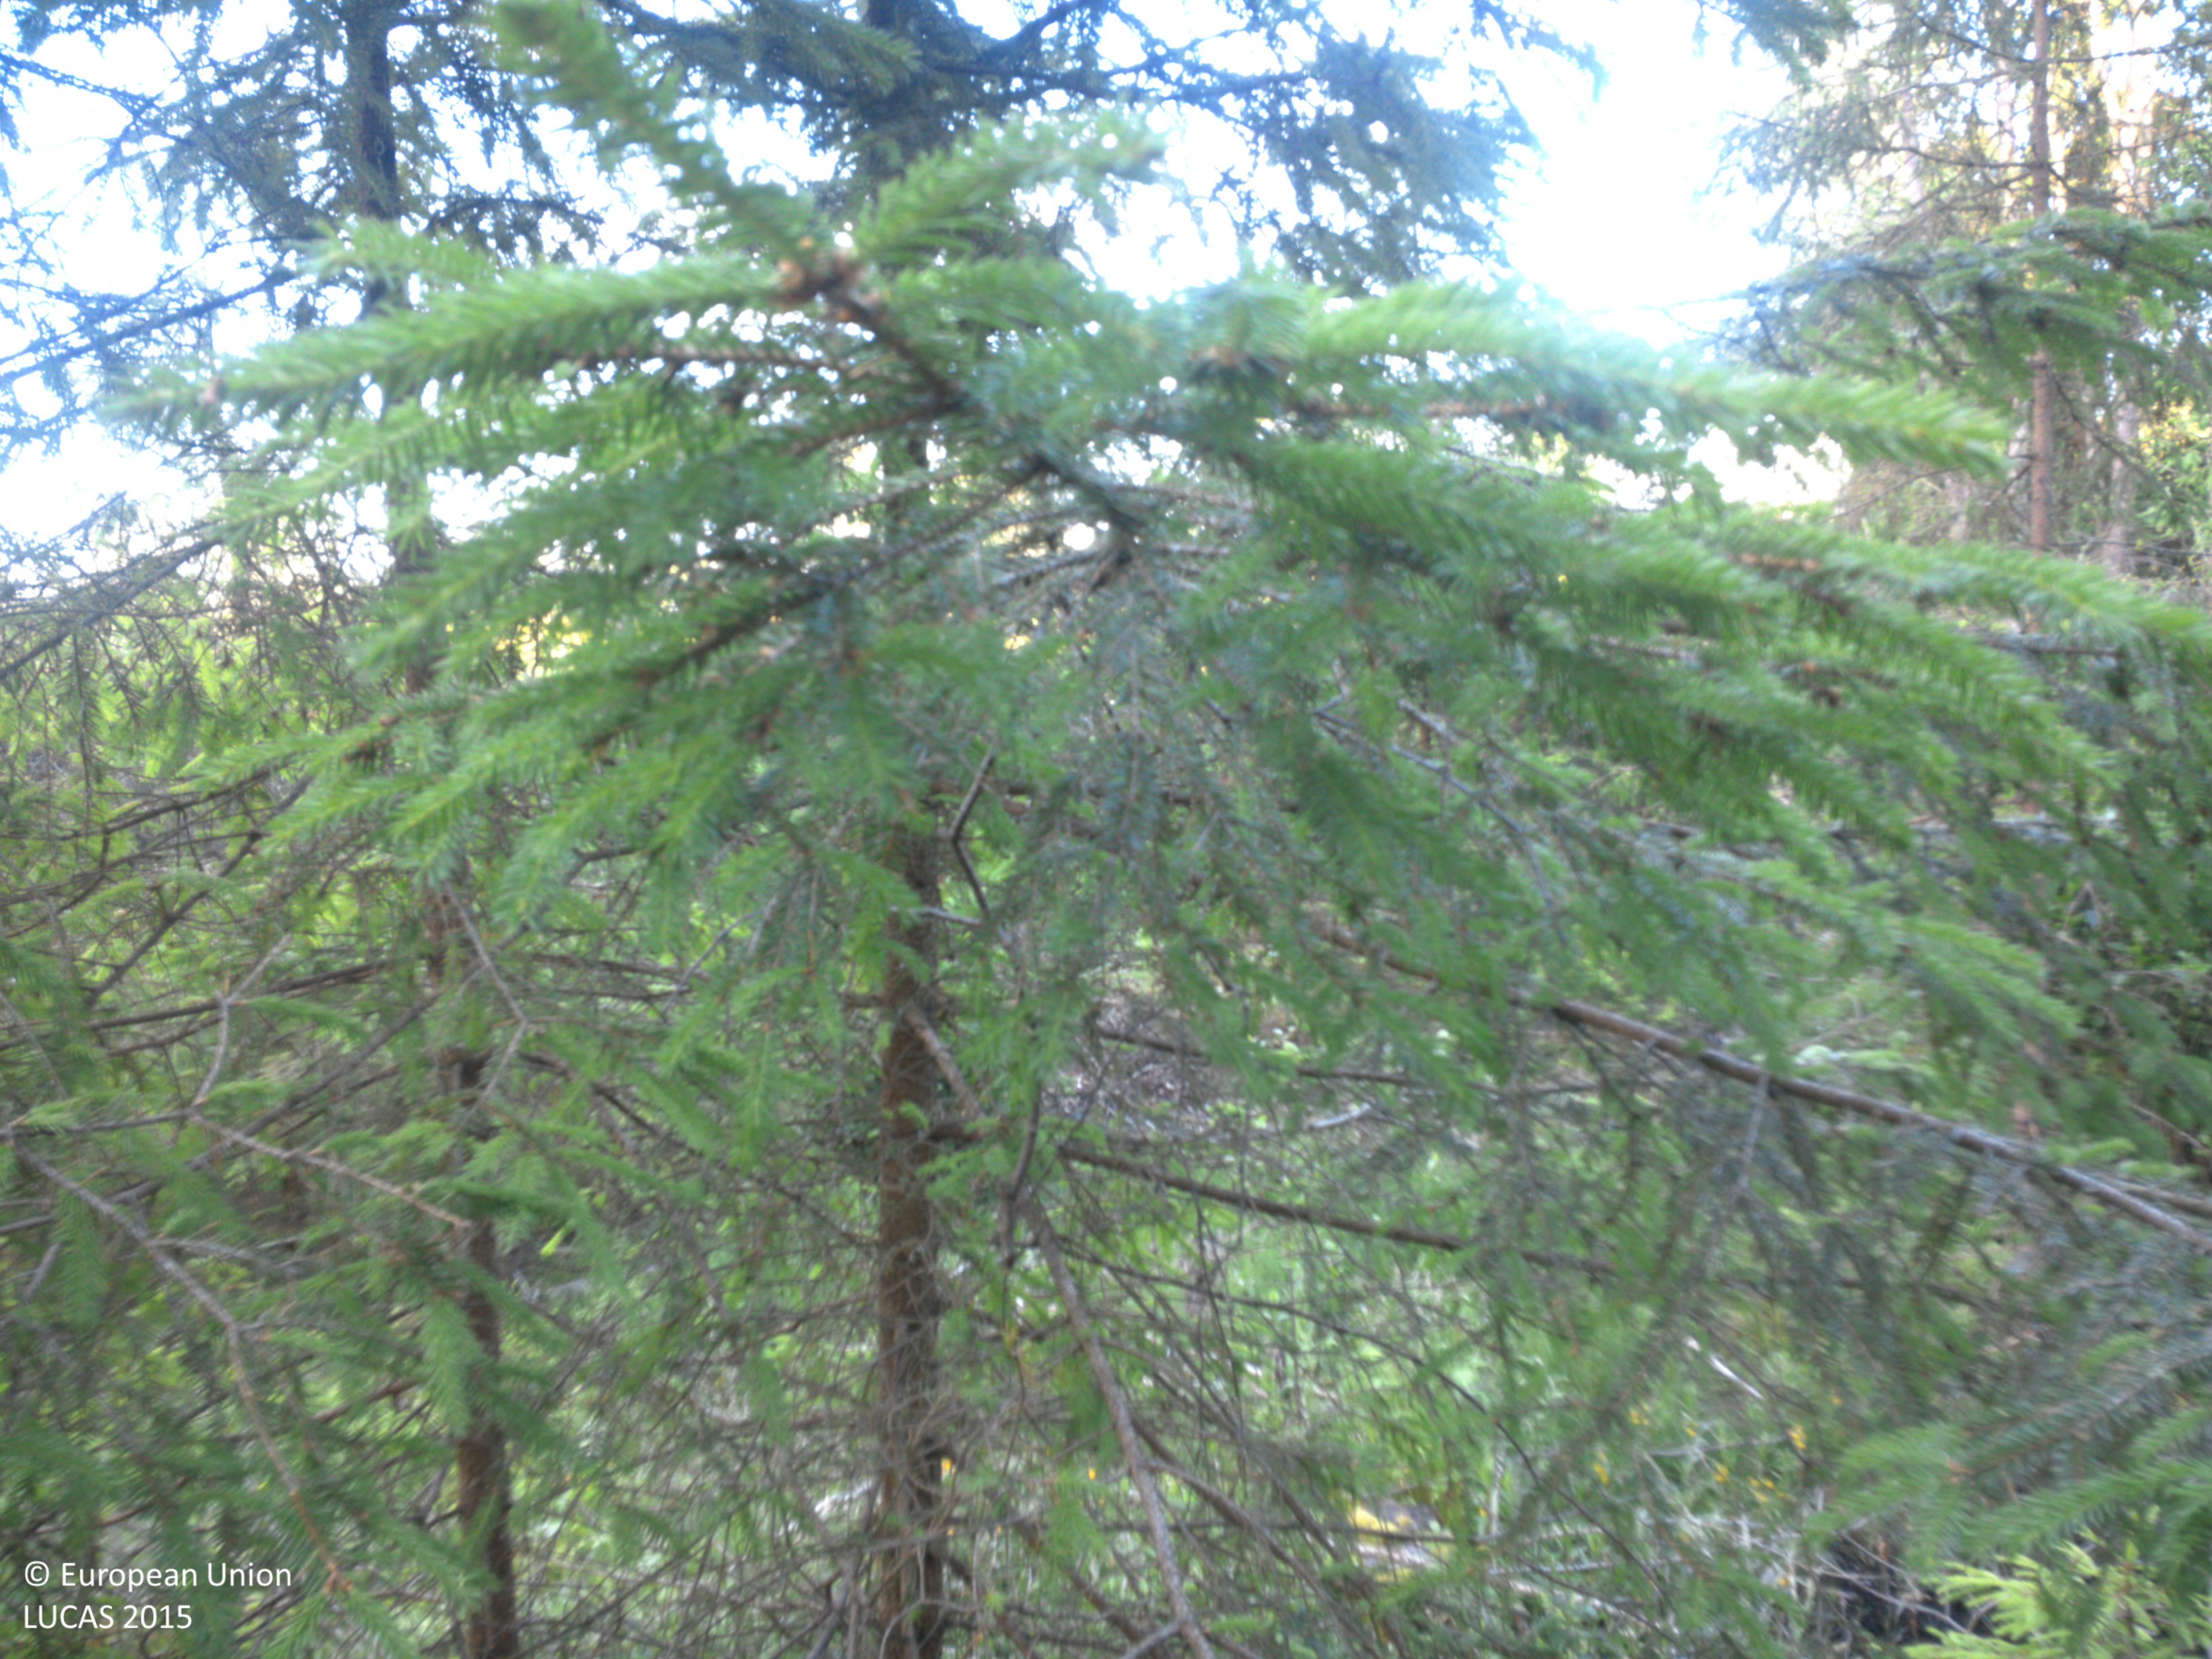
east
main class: Woodland
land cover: Spruce dominated mixed woodland
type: boreal forest
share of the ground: 25 - 50 %
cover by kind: herbaceous plants 40 %, coniferous forest trees 30 %, broadleaved forest trees 15 %, shrubs 15 %
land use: Forestry
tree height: < 5 m
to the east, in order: Spruce dominated mixed woodland; Rivers and streams; Fences; Spruce dominated mixed woodland; Ditches and canals; Grassland with sparse tree/shrub cover; Fences; Grassland with sparse tree/shrub cover; Broadleaved woodland; Rivers and streams; Broadleaved woodland; Grassland with sparse tree/shrub cover
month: June
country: SE
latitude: 58.8224
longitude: 11.5378
